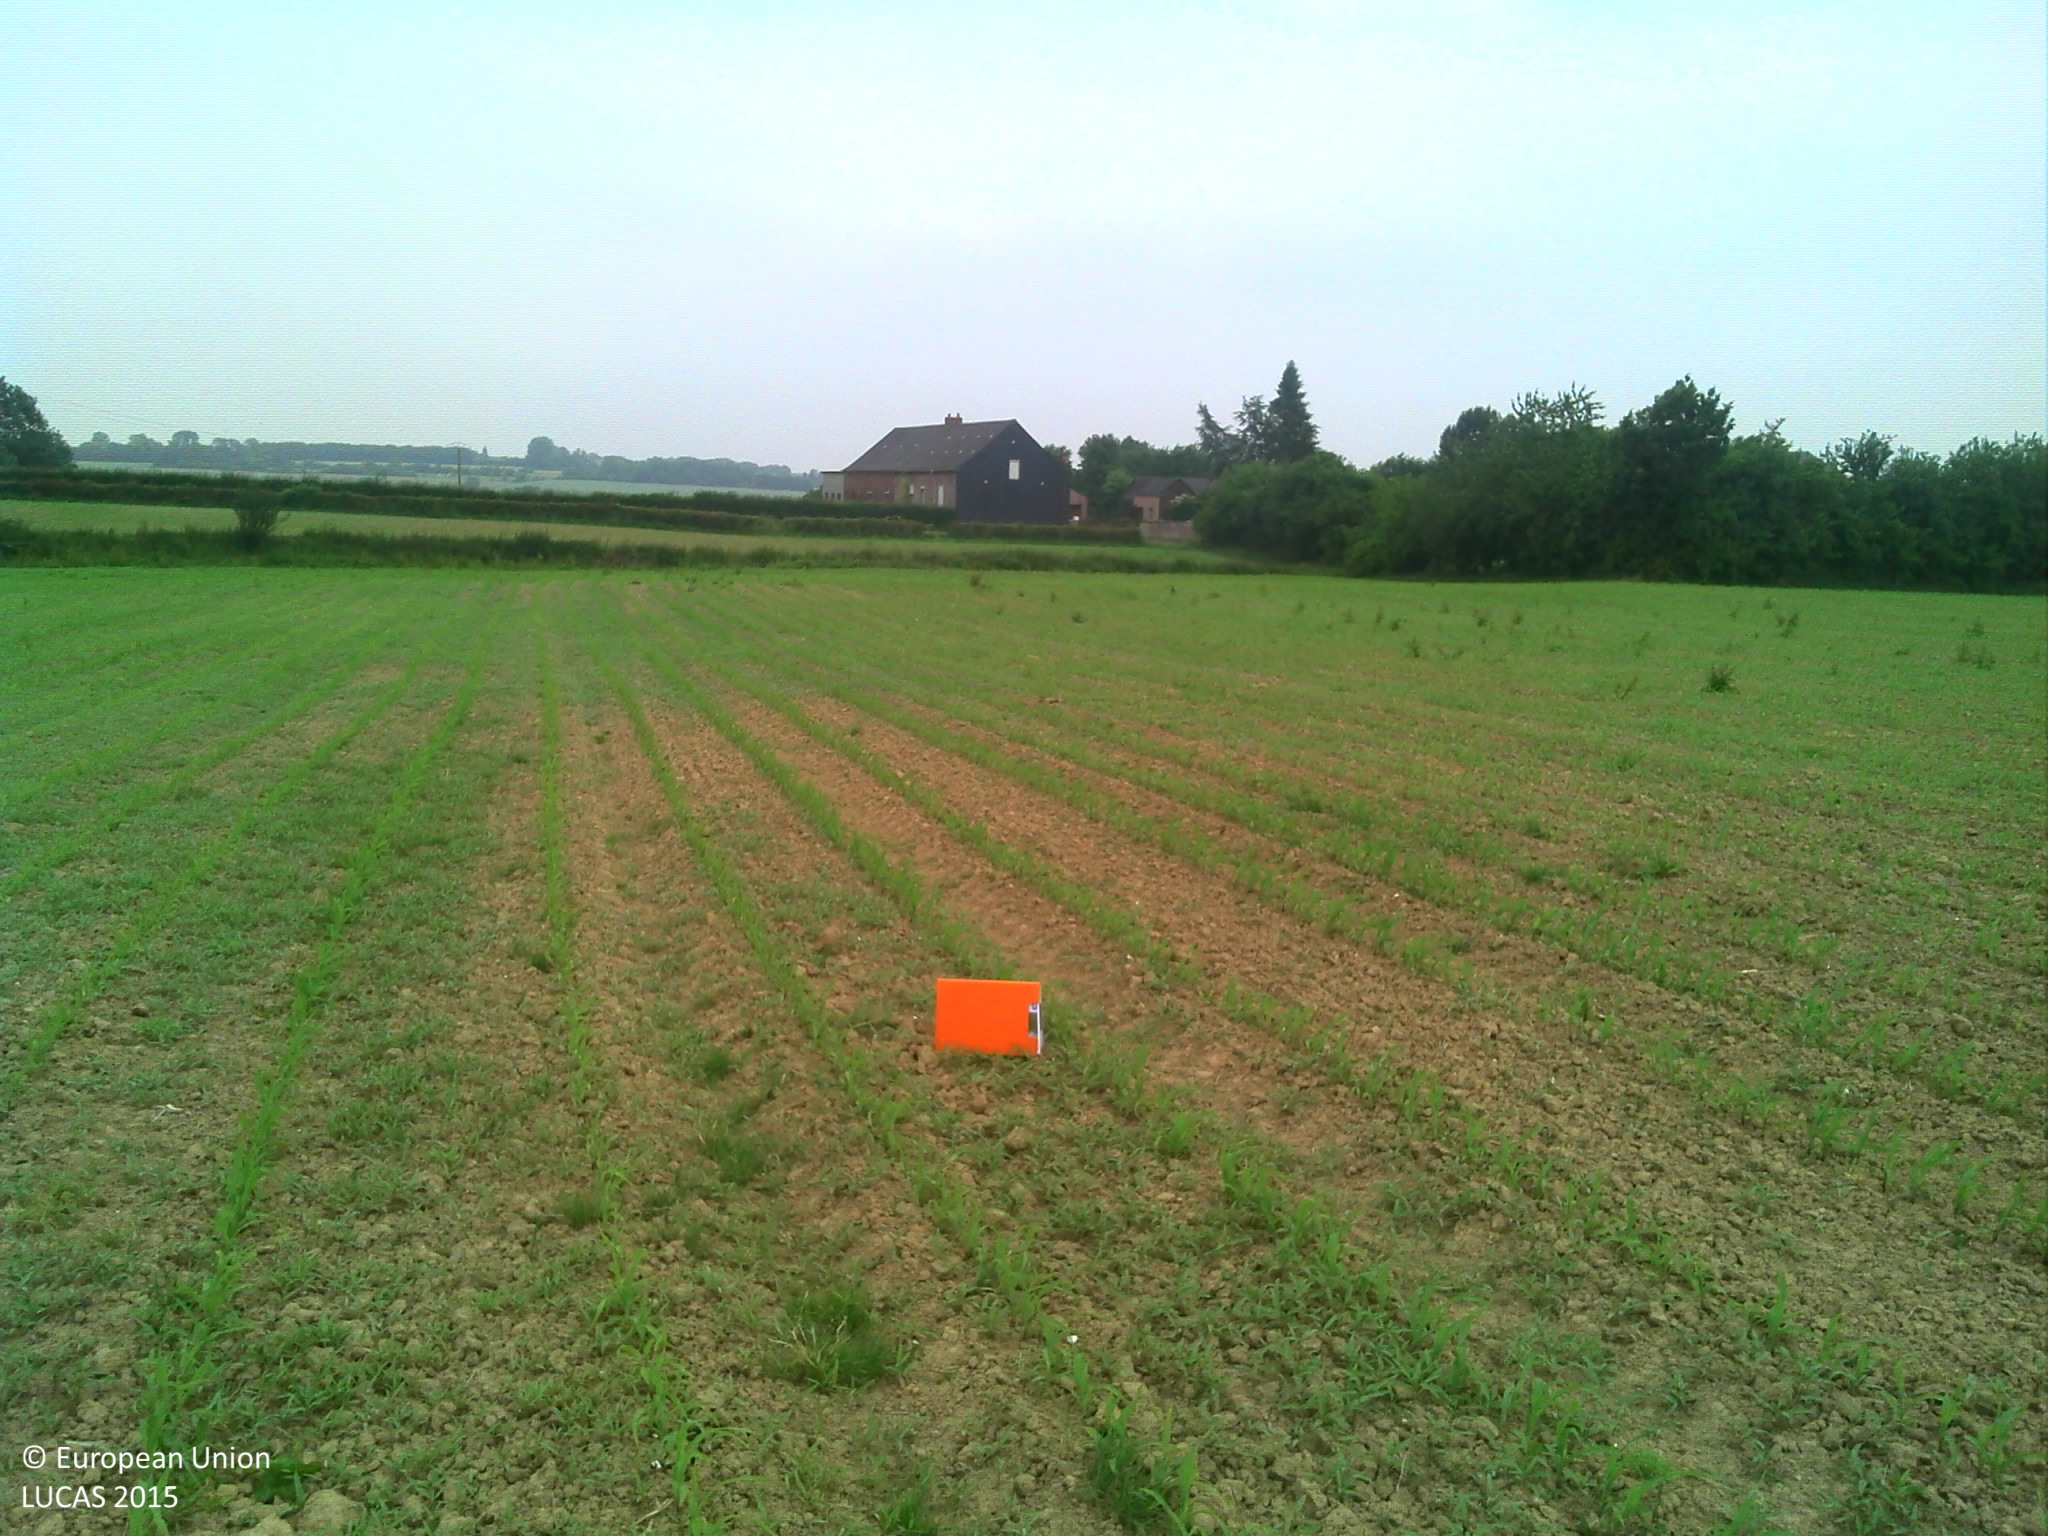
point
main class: Cropland
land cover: Maize
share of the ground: 10 - 25 %
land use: Agriculture (excluding fallow land and kitchen gardens)
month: June
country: FR
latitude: 49.9534
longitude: 3.9873
